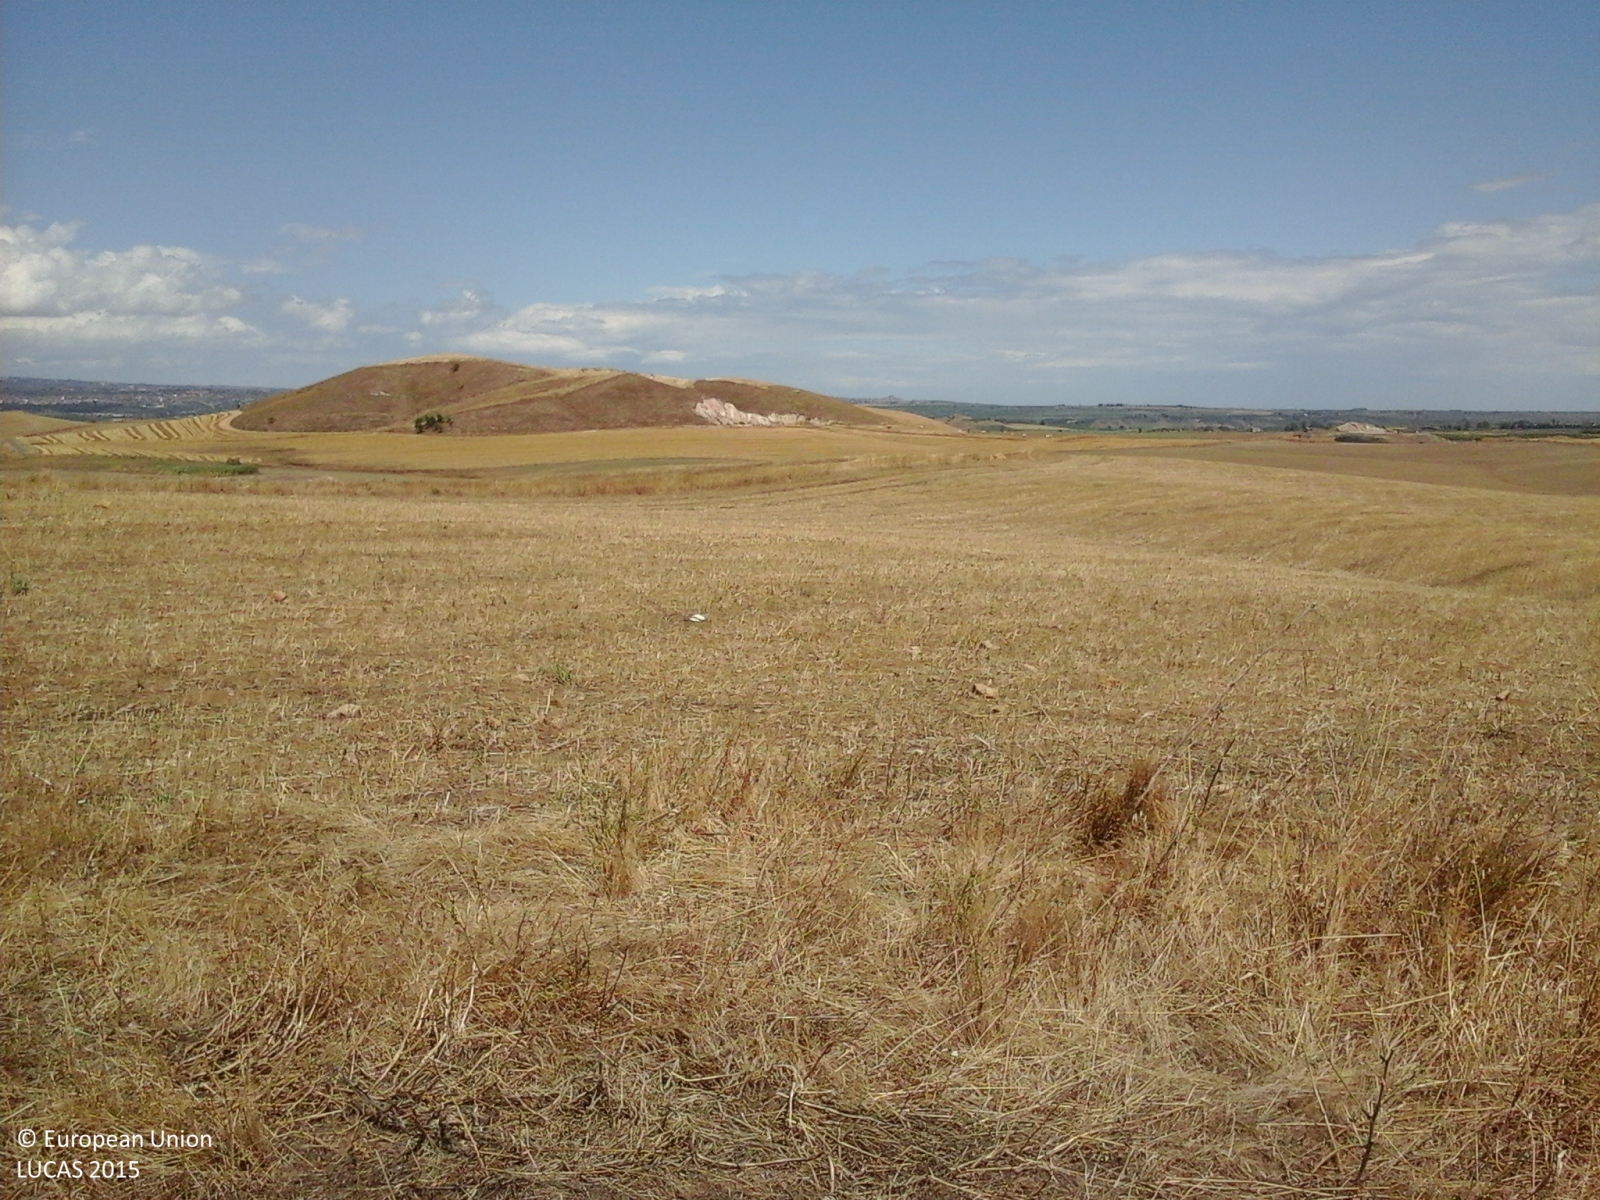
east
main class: Cropland
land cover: Mixed cereals for fodder
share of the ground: > 75 %
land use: Agriculture (excluding fallow land and kitchen gardens)
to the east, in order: Mixed cereals for fodder; Grassland without tree/shrub cover; Inland fresh water bodies; Grassland without tree/shrub cover; Mixed cereals for fodder
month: June
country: IT
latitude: 37.5344
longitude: 14.8201
